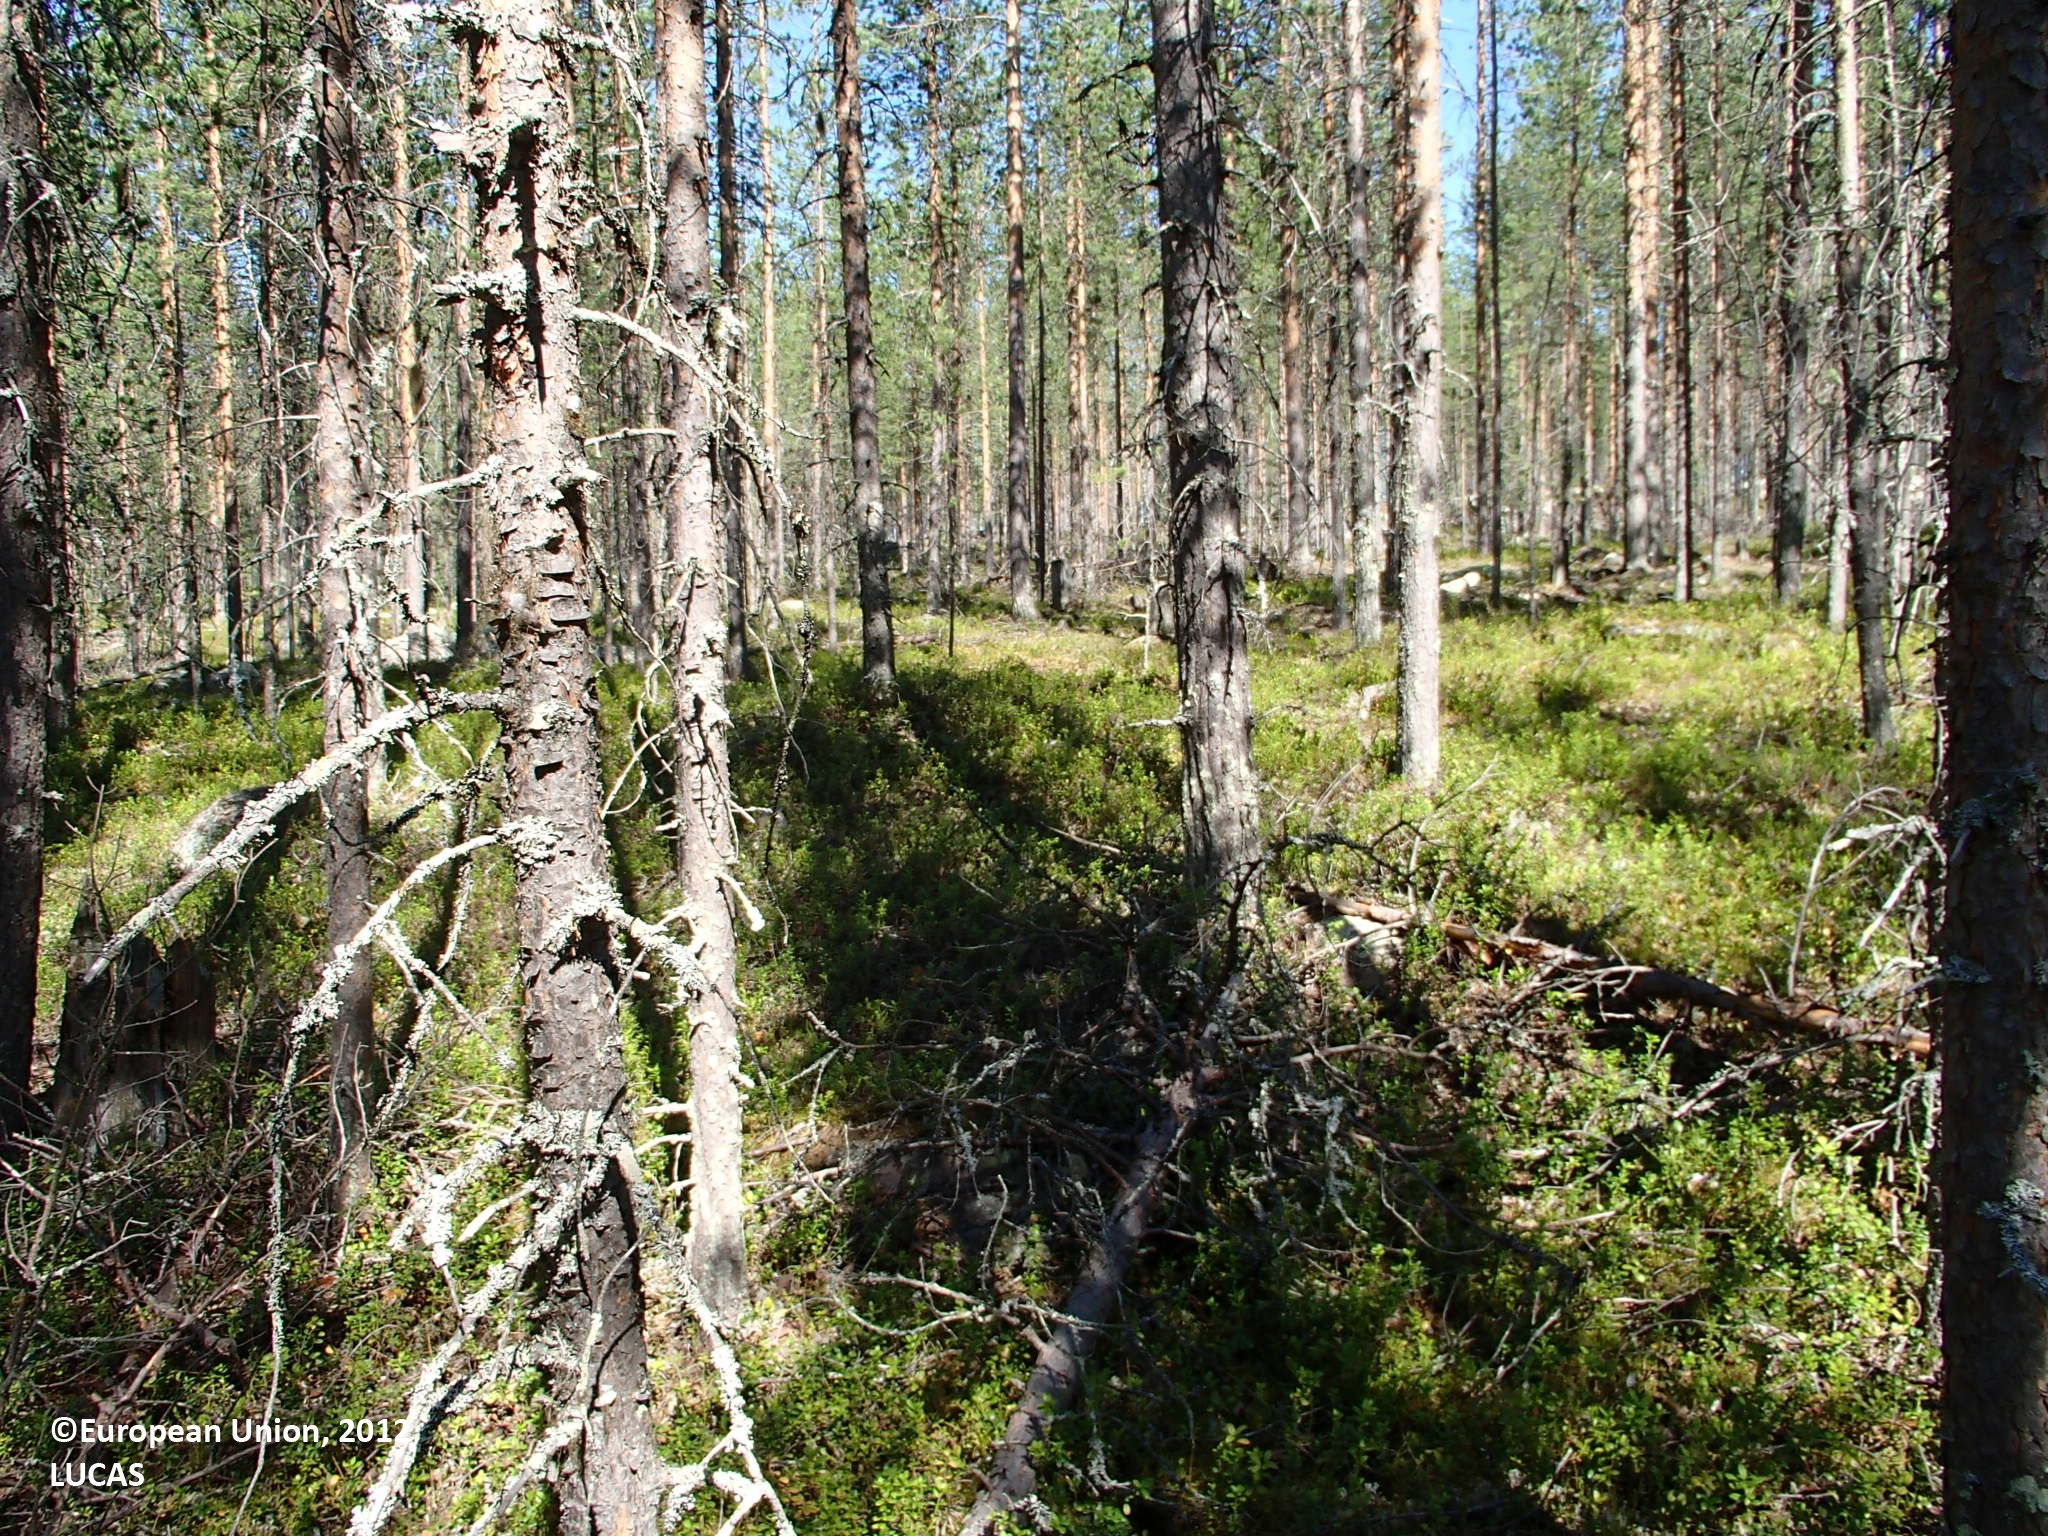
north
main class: Woodland
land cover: Pine dominated coniferous woodland
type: boreal forest
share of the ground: 50 - 75 %
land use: Forestry
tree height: > 5 m
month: July
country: FI
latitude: 66.8213
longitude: 25.4259
